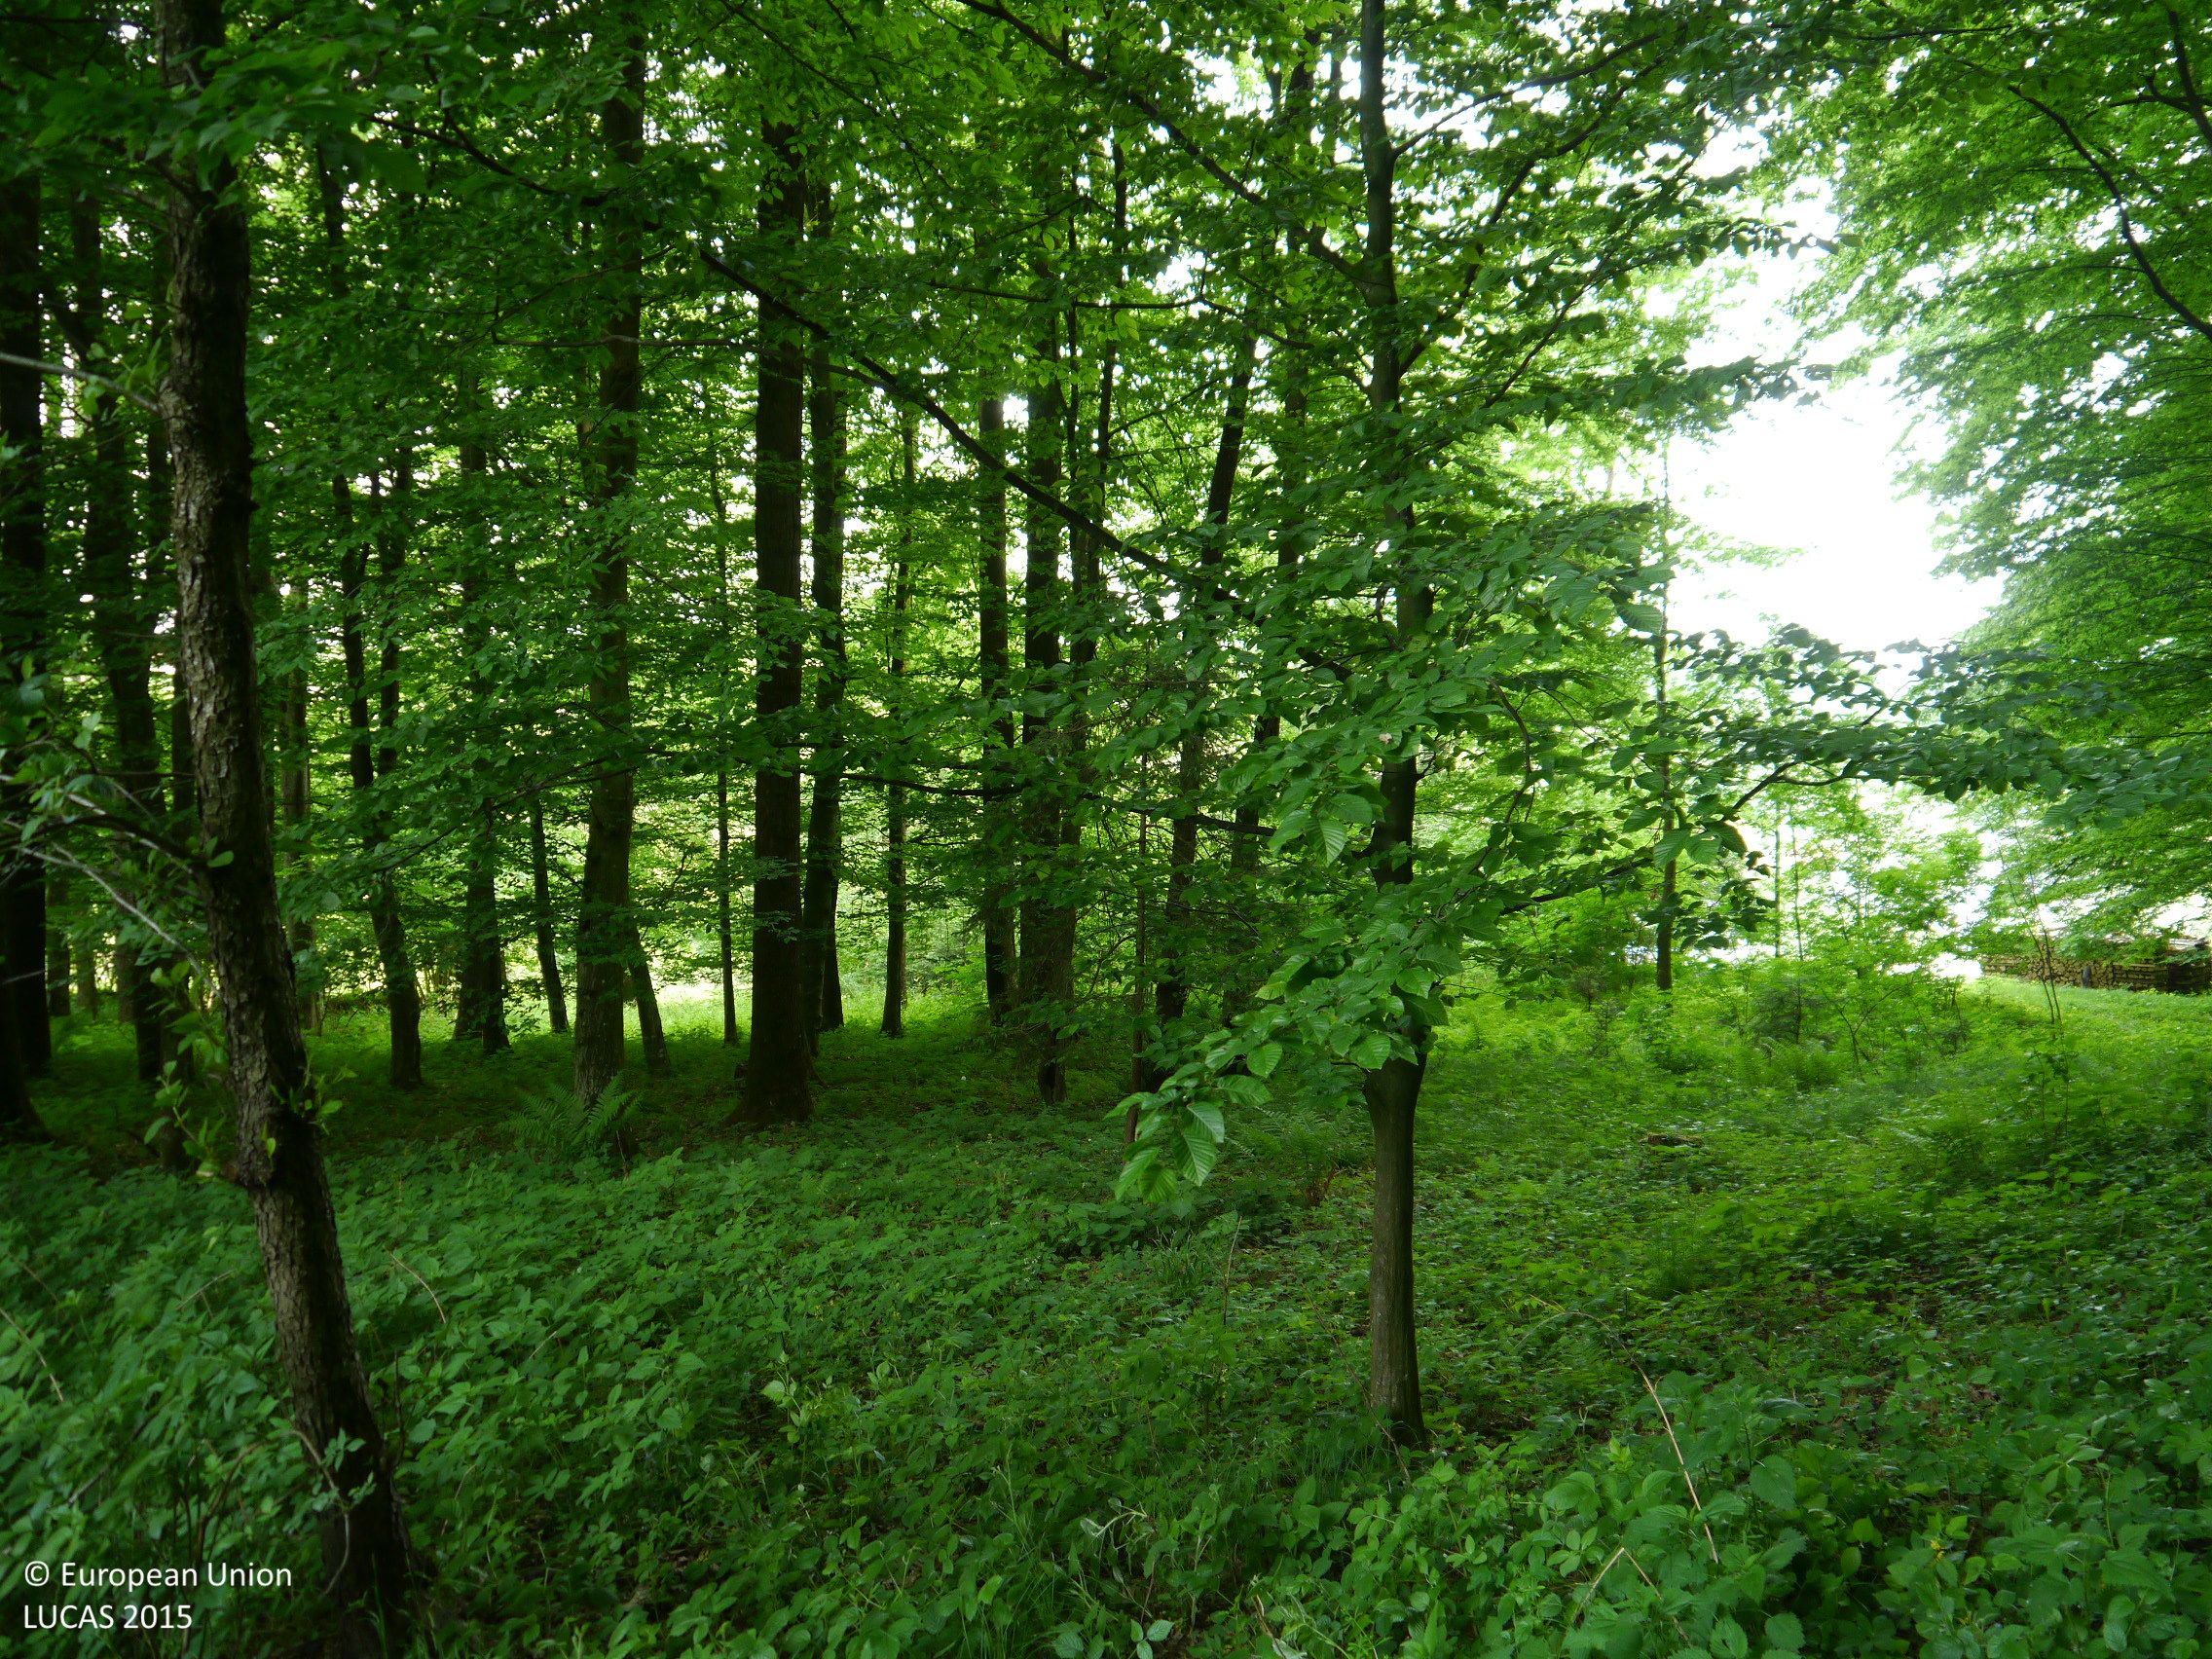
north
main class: Woodland
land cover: Broadleaved woodland
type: hemiboreal forest and nemoral coniferous forest and mixed broadleaved-coniferous forest
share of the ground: > 75 %
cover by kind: broadleaved forest trees 80 %, herbaceous plants 20 %
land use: Forestry
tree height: > 5 m
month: May
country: AT
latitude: 46.9745
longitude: 15.7183
